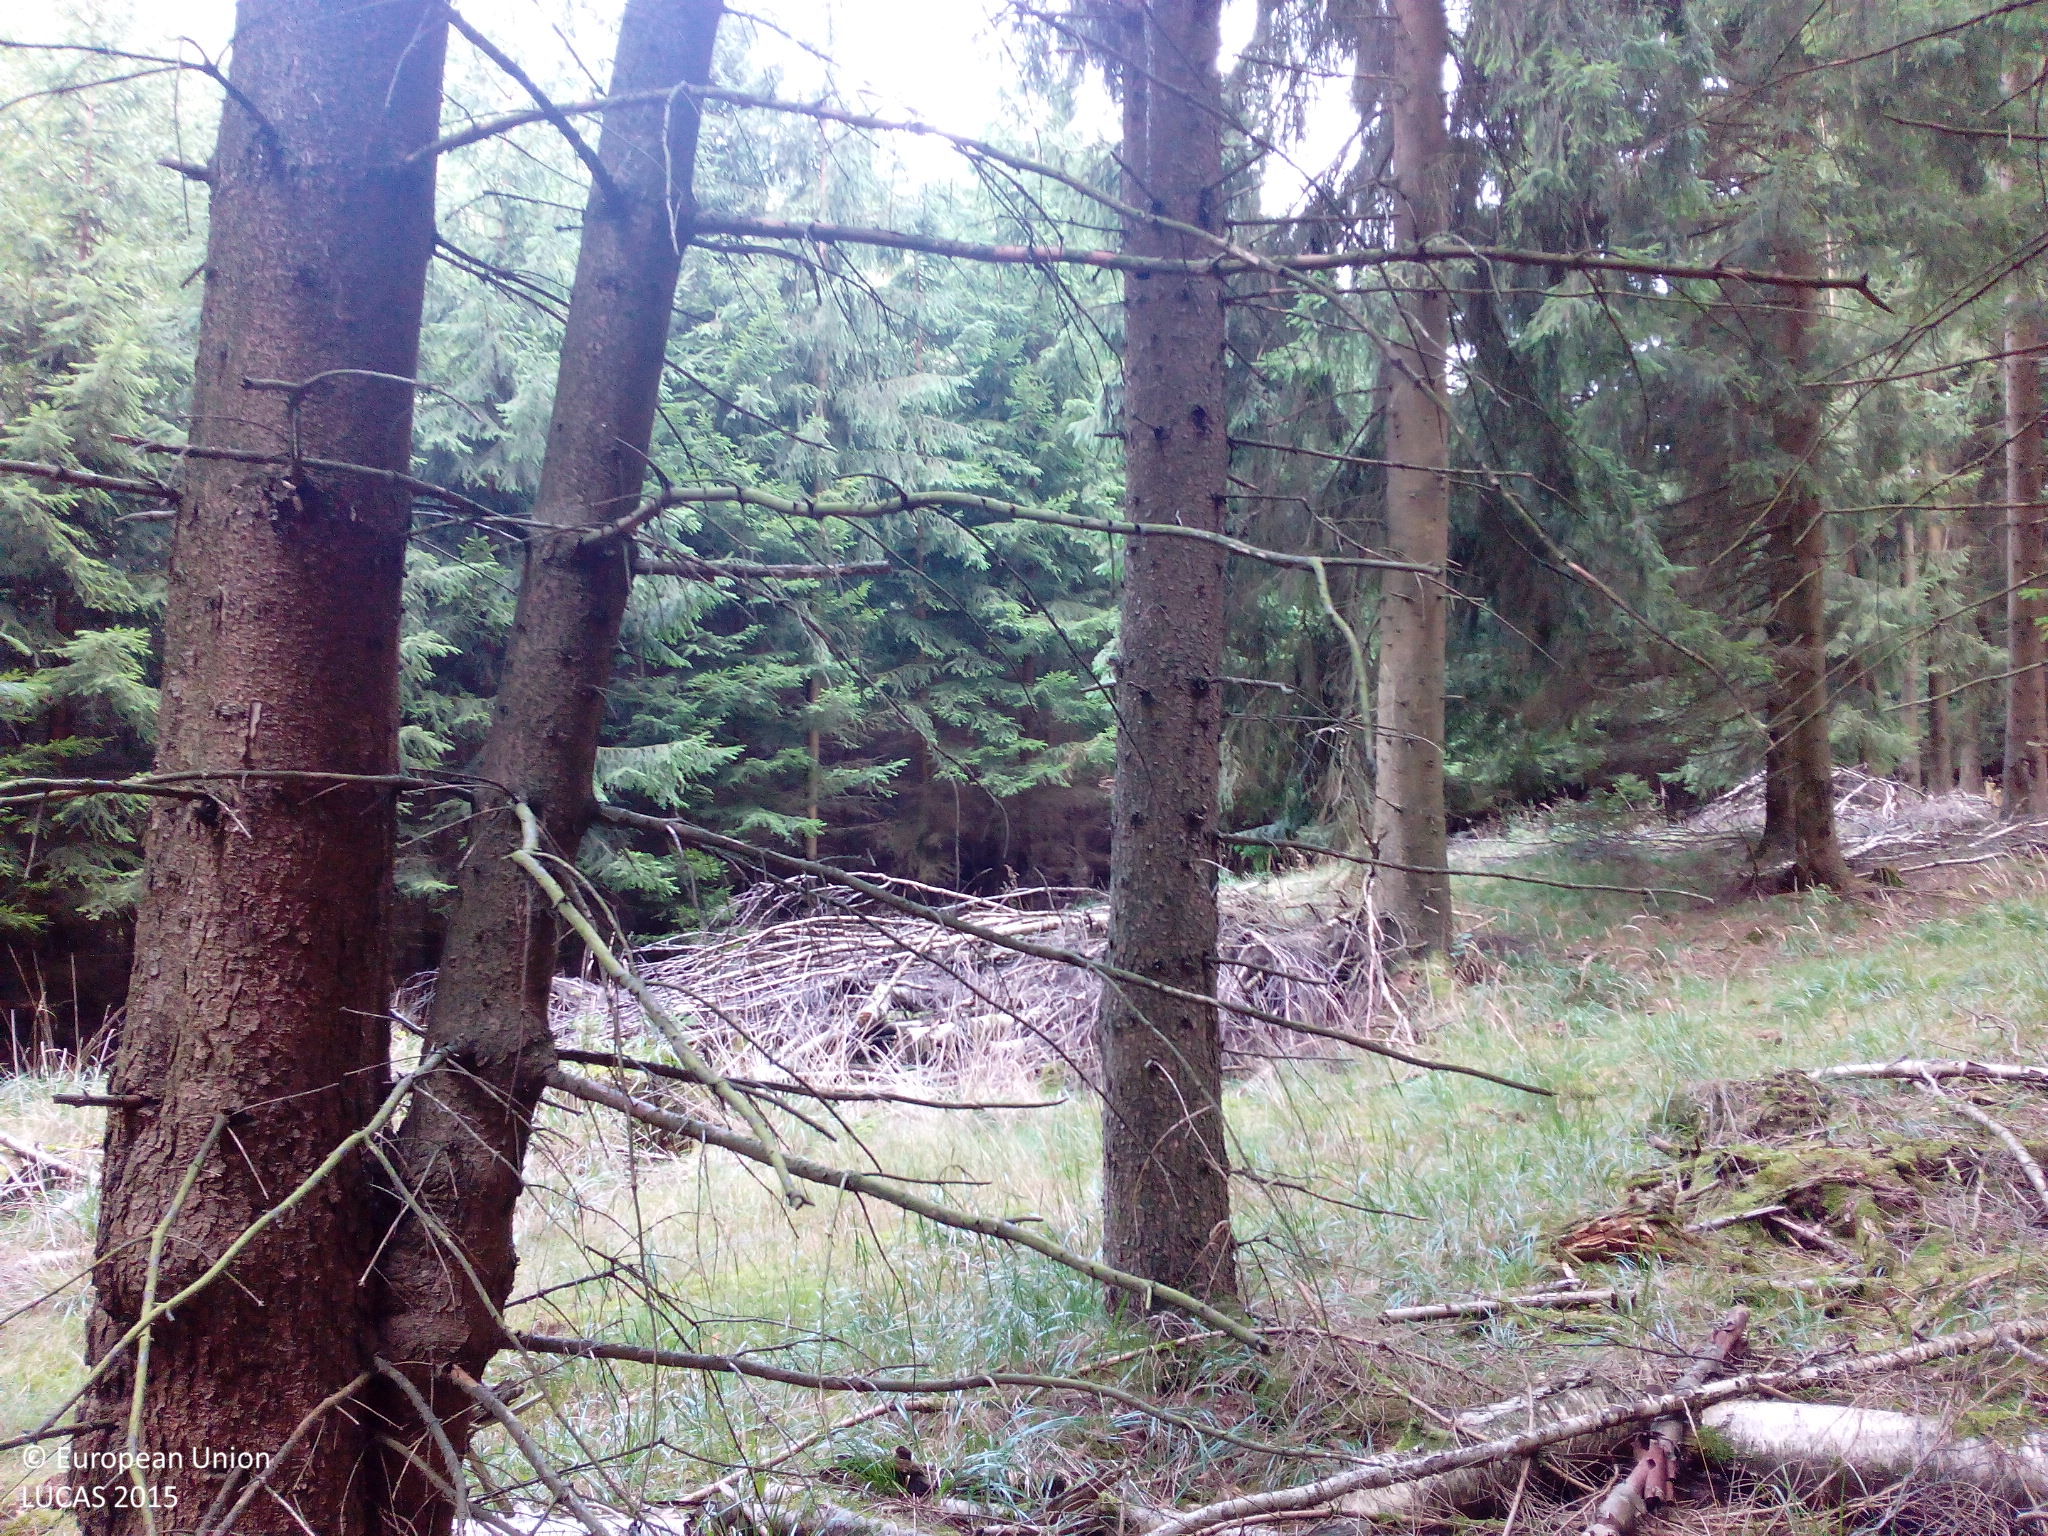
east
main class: Woodland
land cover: Spruce dominated coniferous woodland
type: hemiboreal forest and nemoral coniferous forest and mixed broadleaved-coniferous forest
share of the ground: > 75 %
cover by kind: coniferous forest trees 90 %, broadleaved forest trees 10 %
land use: Forestry
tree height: > 5 m
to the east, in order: Spruce dominated coniferous woodland; Tracks; Spruce dominated coniferous woodland; Spruce dominated mixed woodland
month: September
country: DE
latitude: 51.5821
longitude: 11.0243
